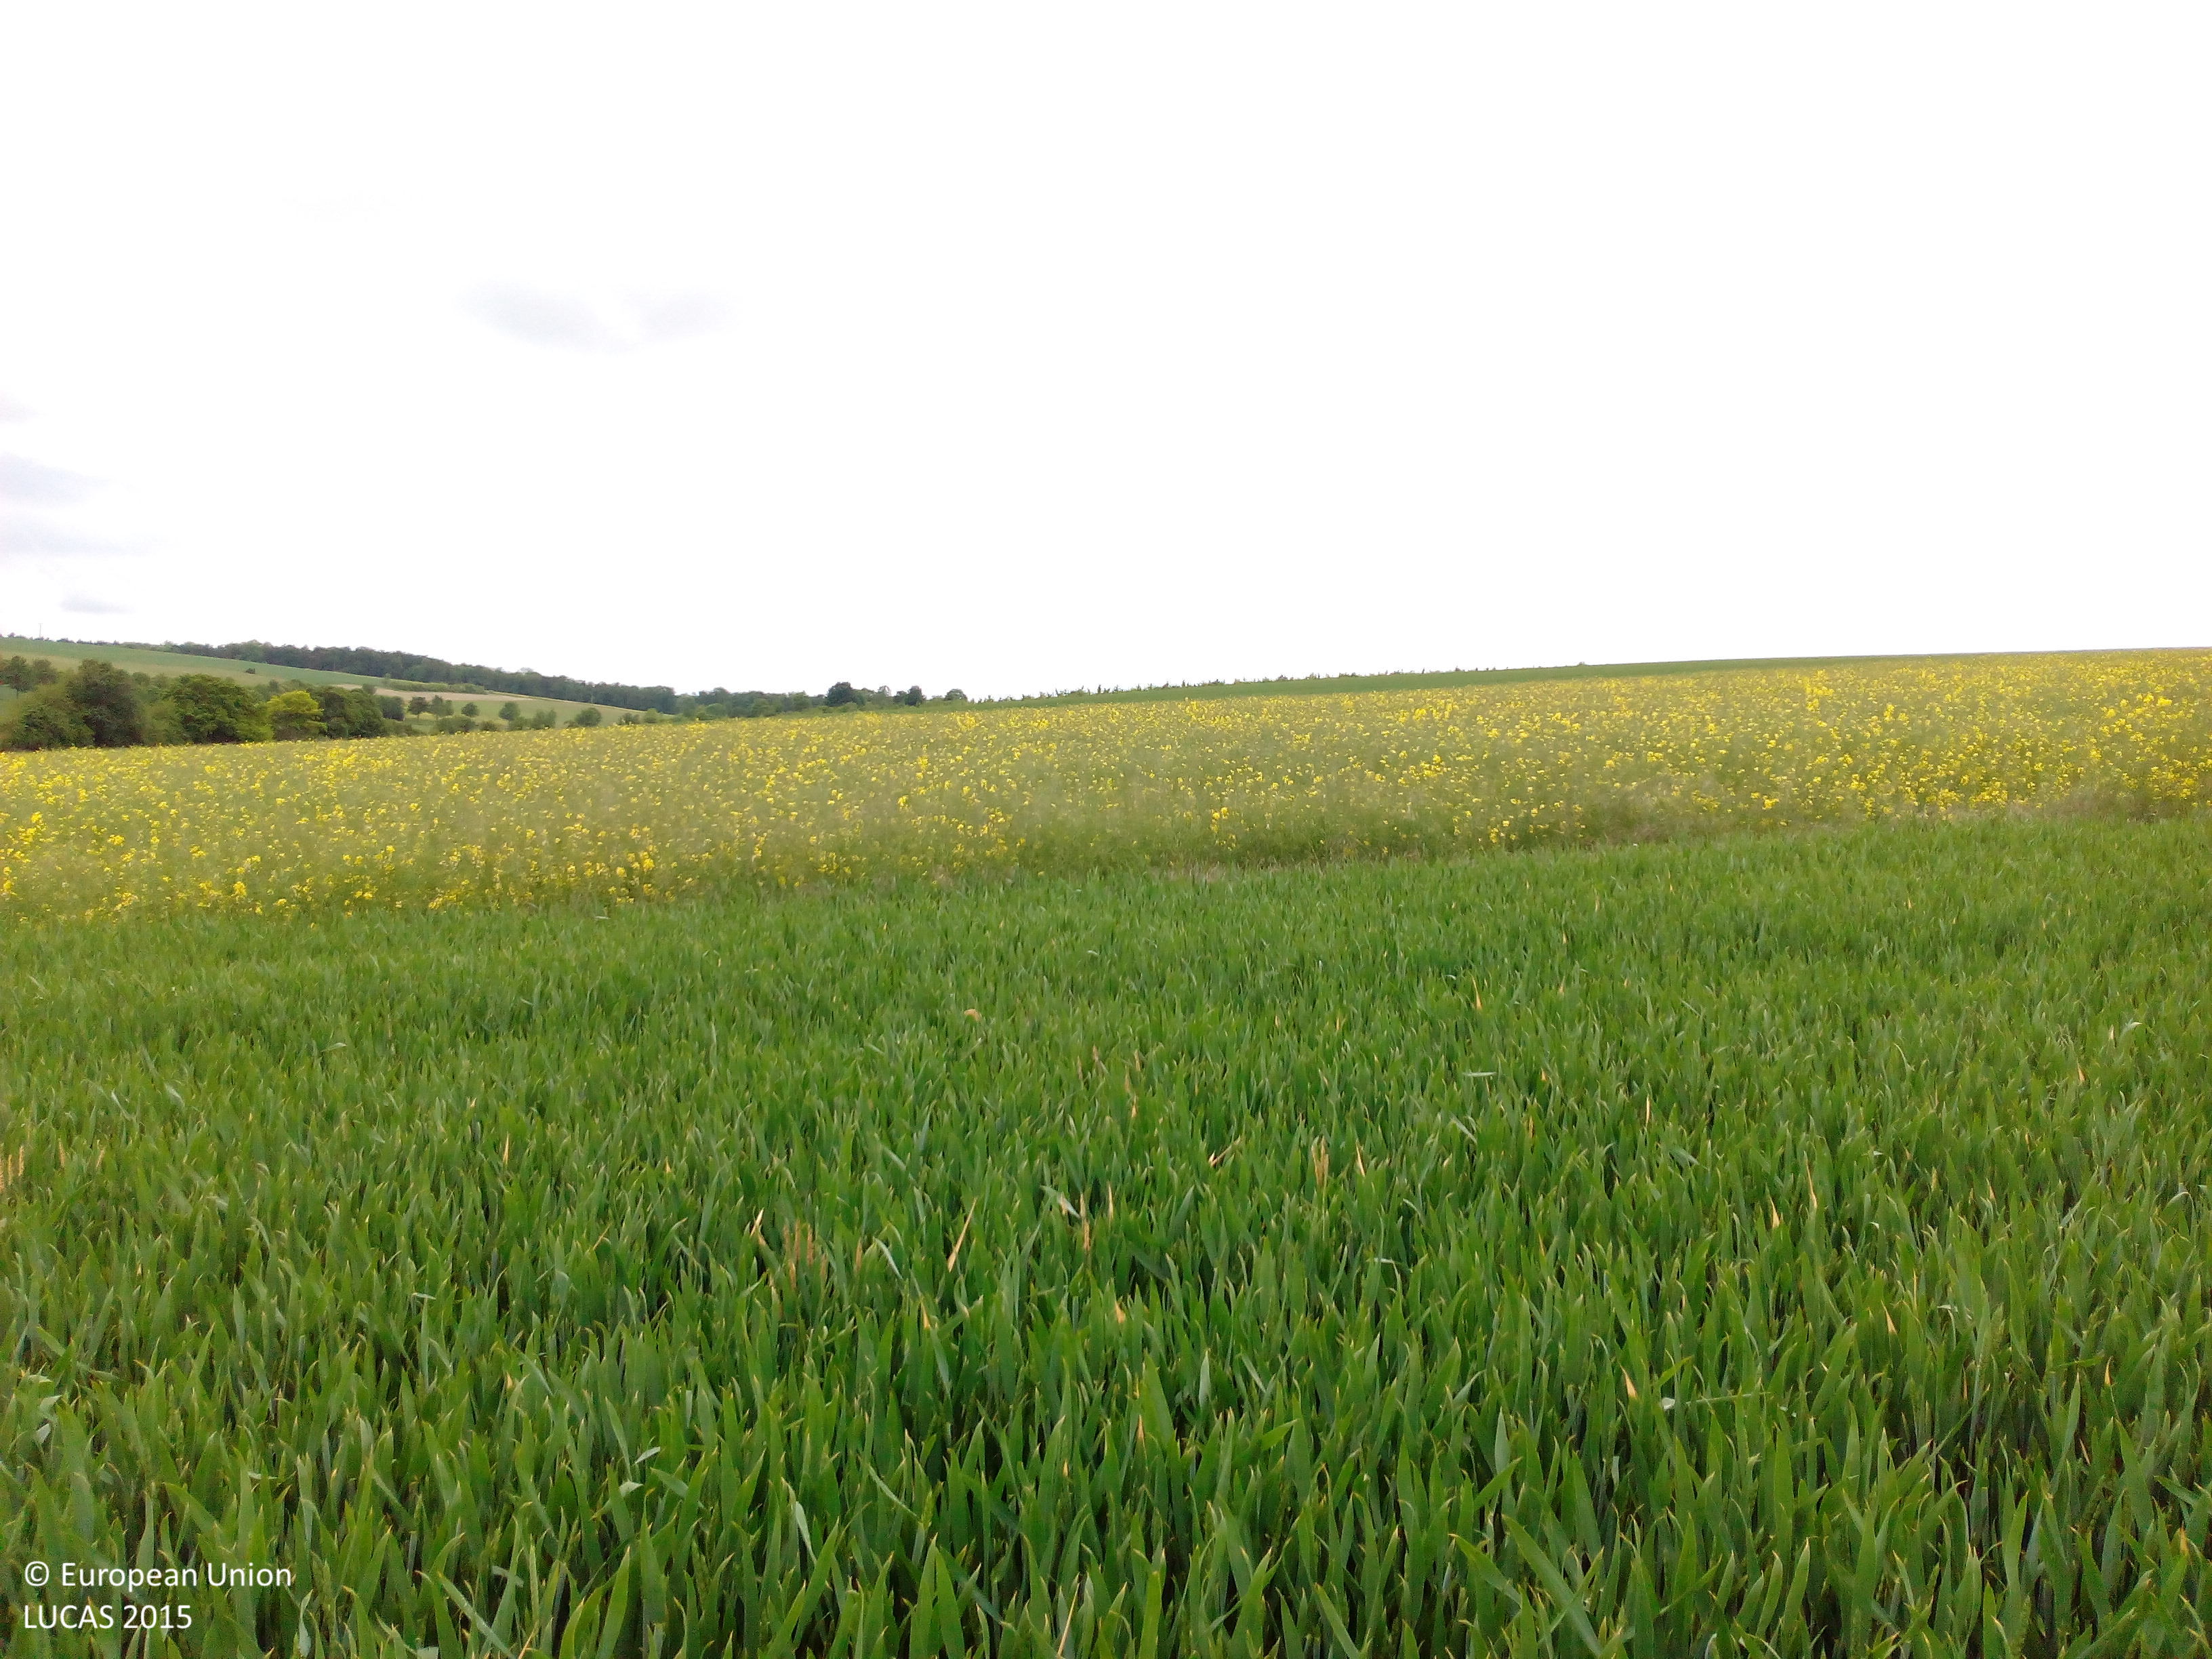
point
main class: Cropland
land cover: Rape and turnip rape
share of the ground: > 75 %
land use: Agriculture (excluding fallow land and kitchen gardens)
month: May
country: DE
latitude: 52.0000
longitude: 9.9272
